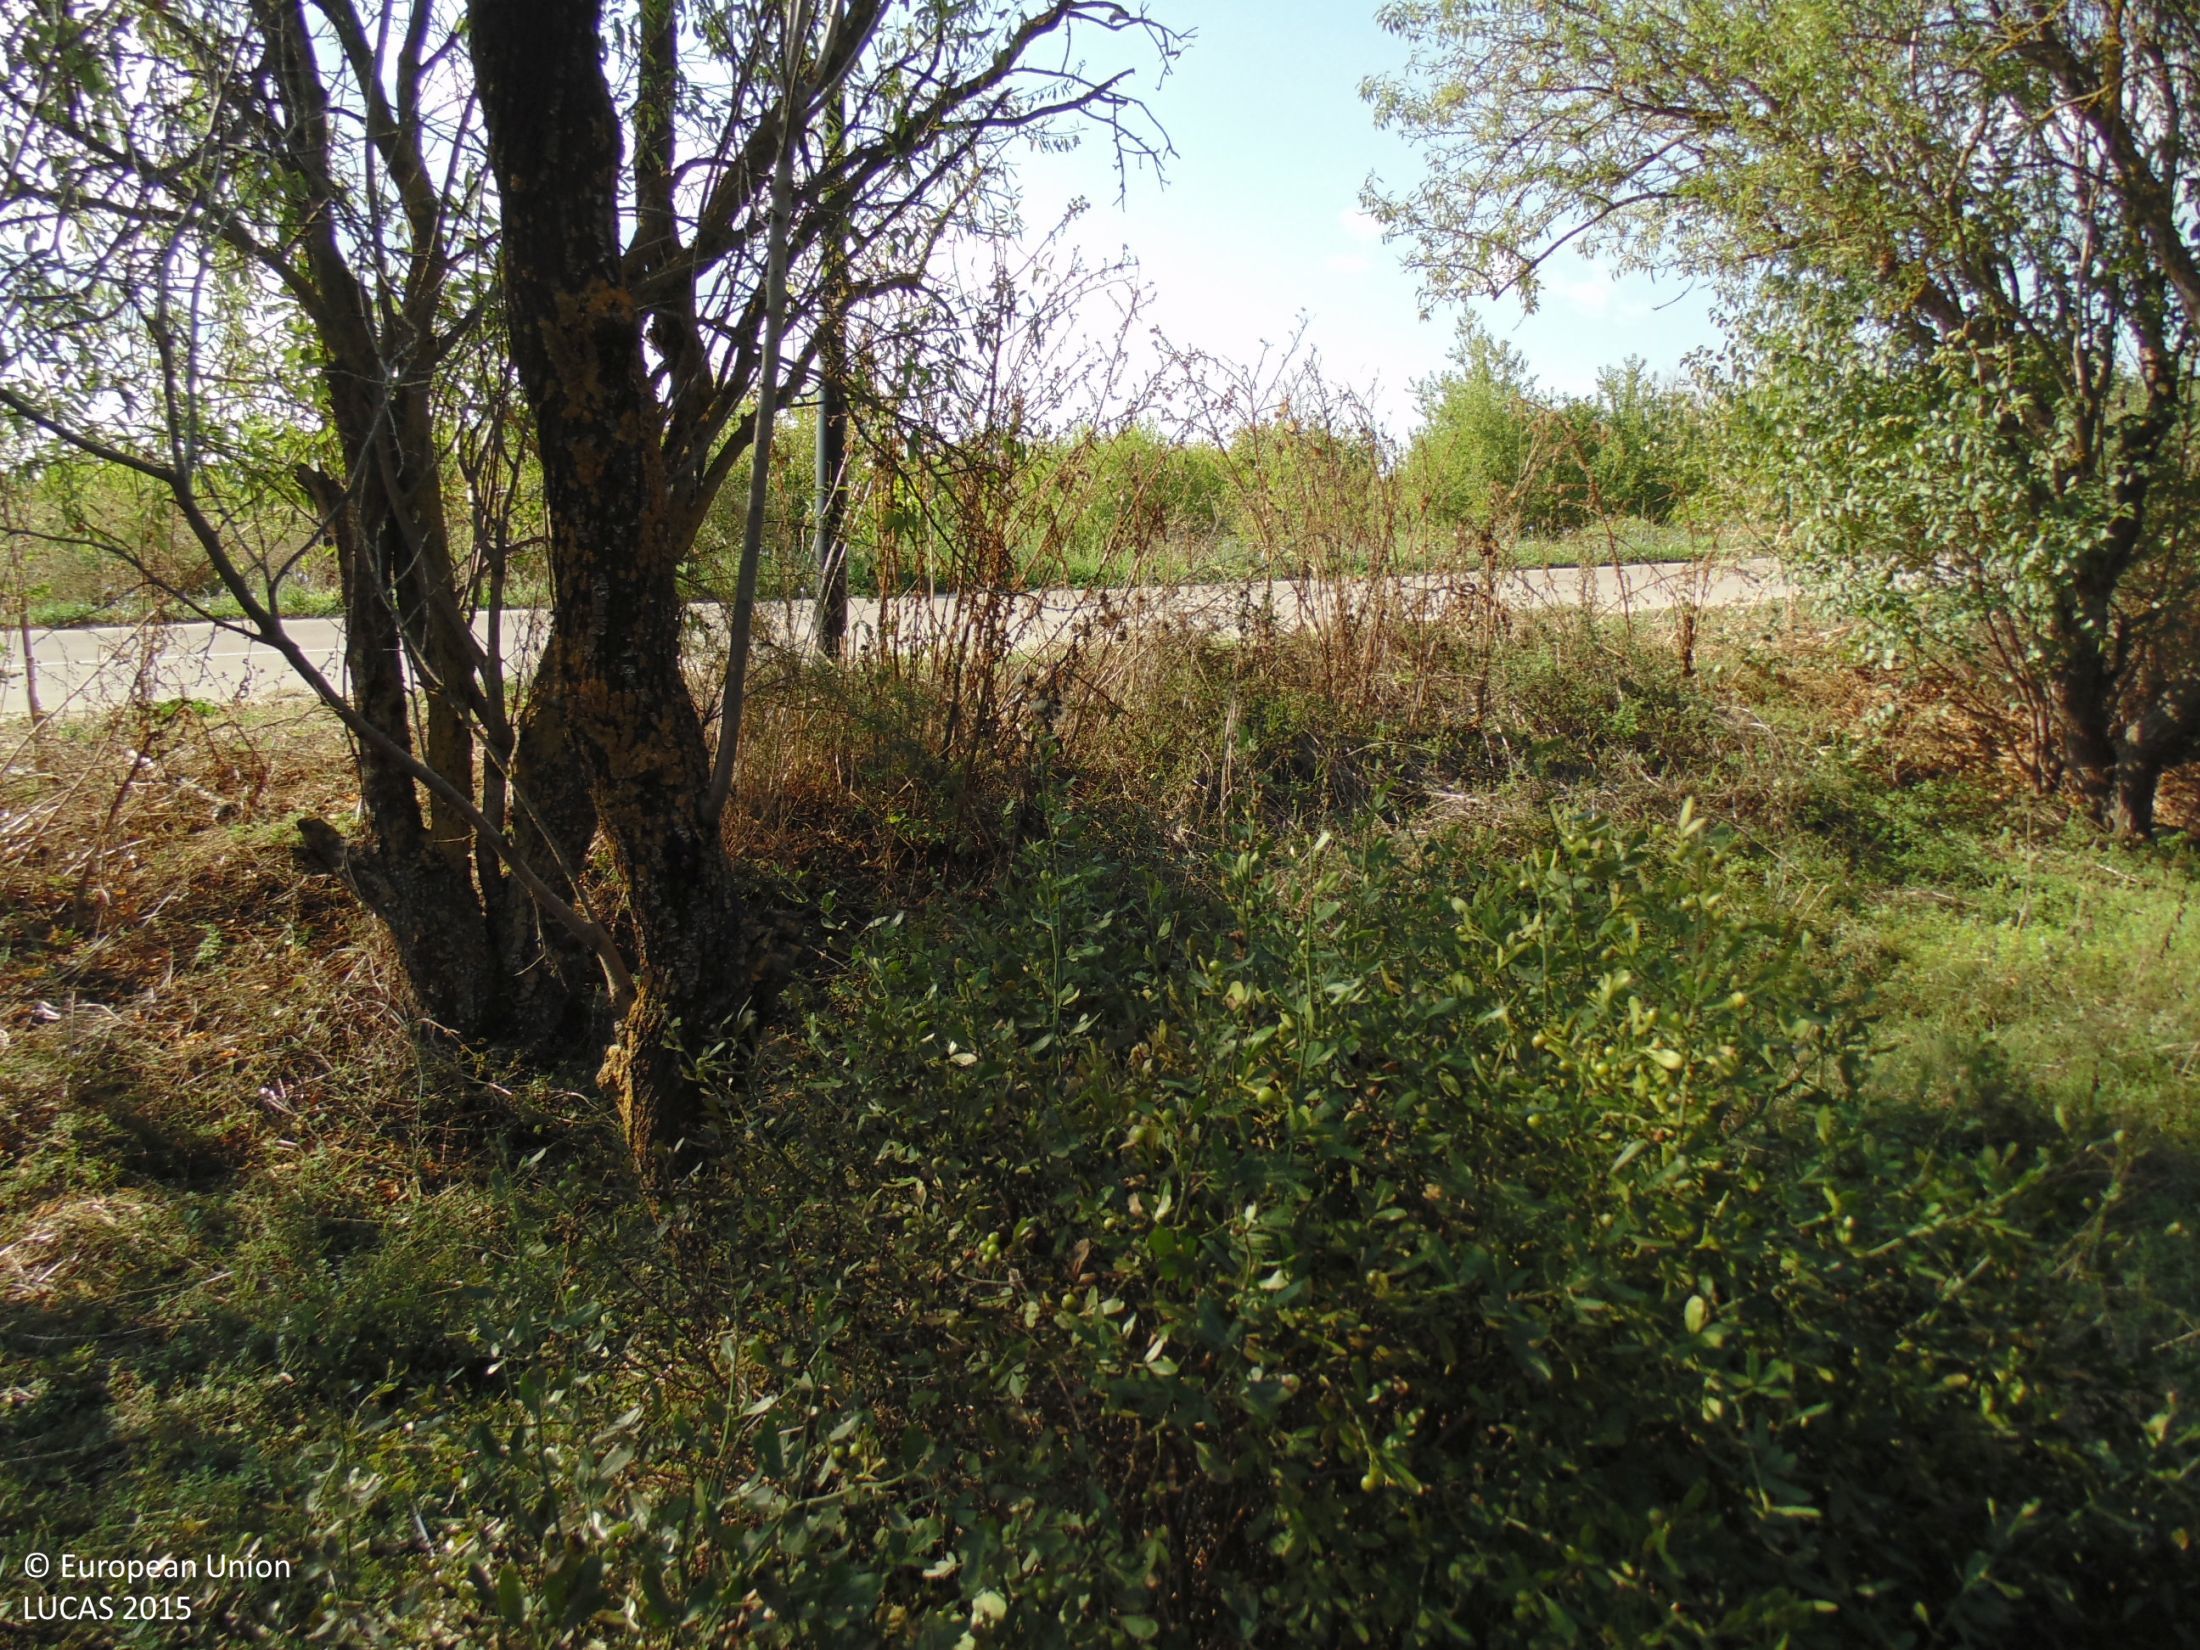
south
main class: Woodland
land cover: Broadleaved woodland
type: mesophytic deciduous forest
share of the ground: > 75 %
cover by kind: broadleaved forest trees 90 %, shrubs 10 %
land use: Forestry
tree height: > 5 m
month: September
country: BG
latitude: 43.4130
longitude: 28.2697
